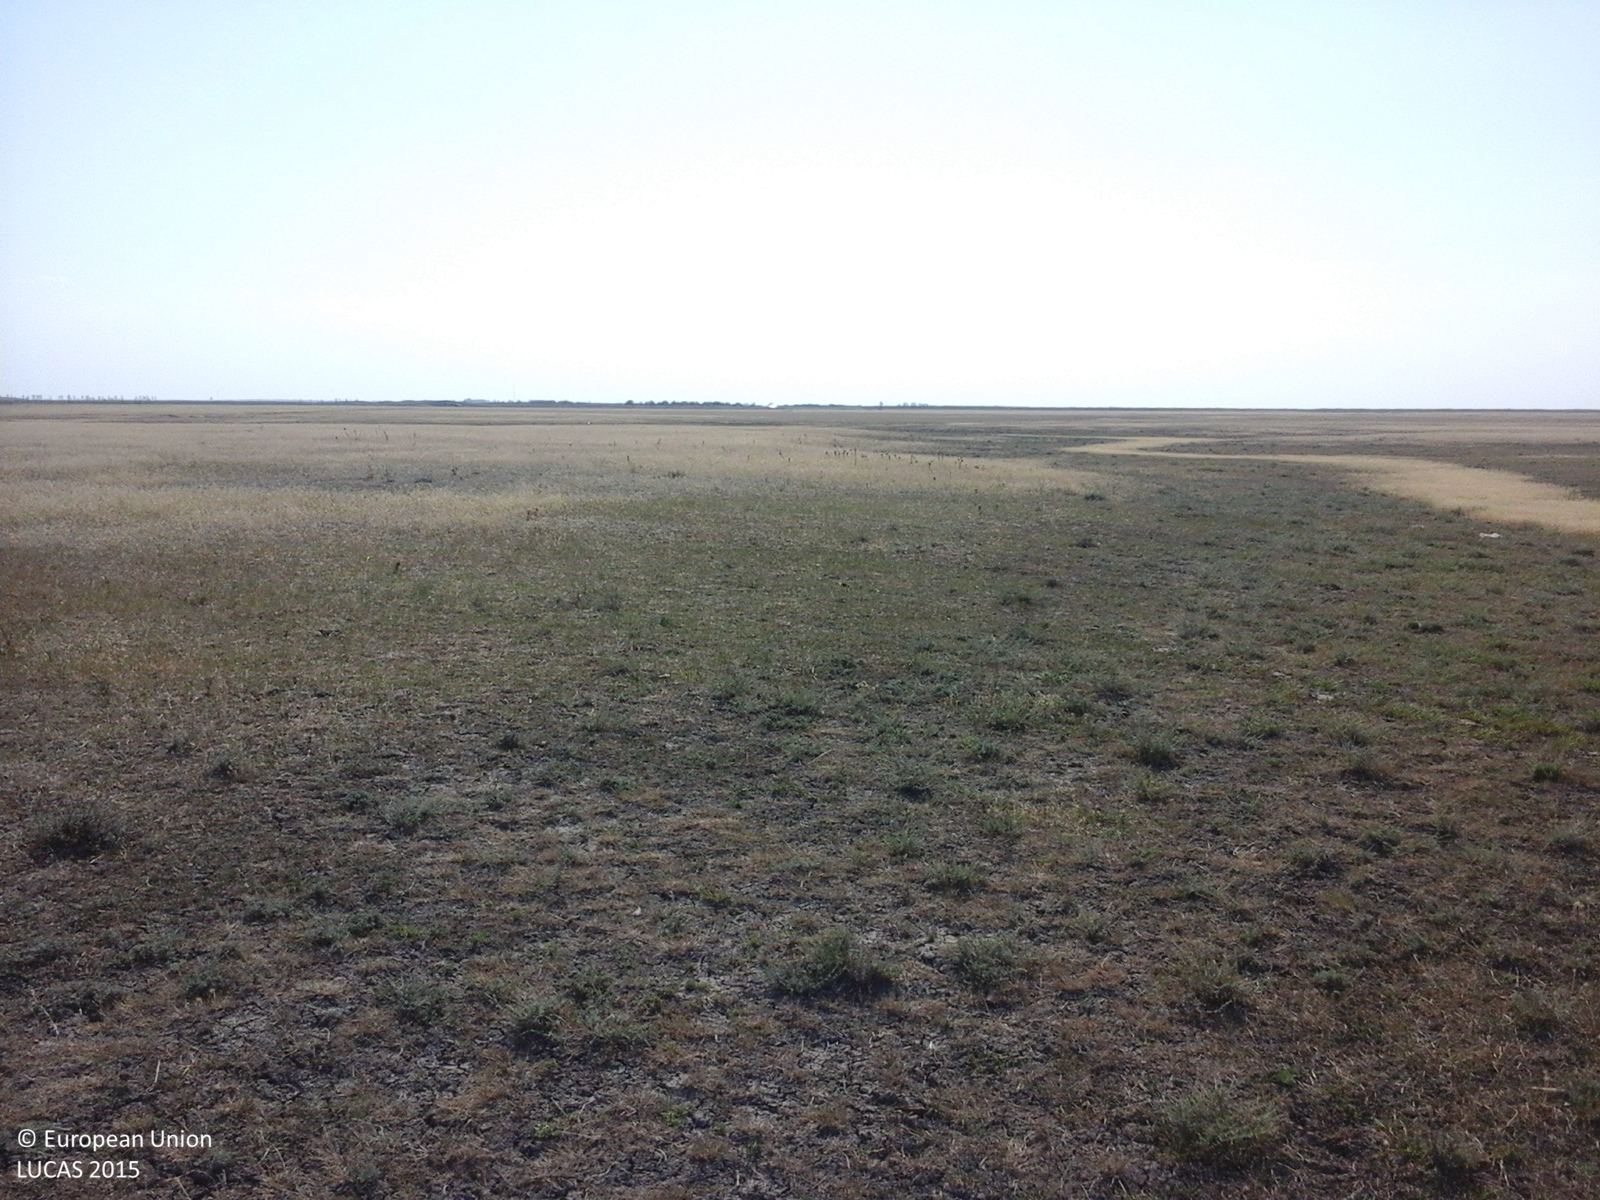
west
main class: Grassland
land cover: Grassland without tree/shrub cover
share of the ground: > 75 %
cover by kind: herbaceous plants 70 %, unconsolidated bare surface 30 %
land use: Agriculture (excluding fallow land and kitchen gardens)
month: July
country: RO
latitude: 44.9793
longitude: 27.4307
